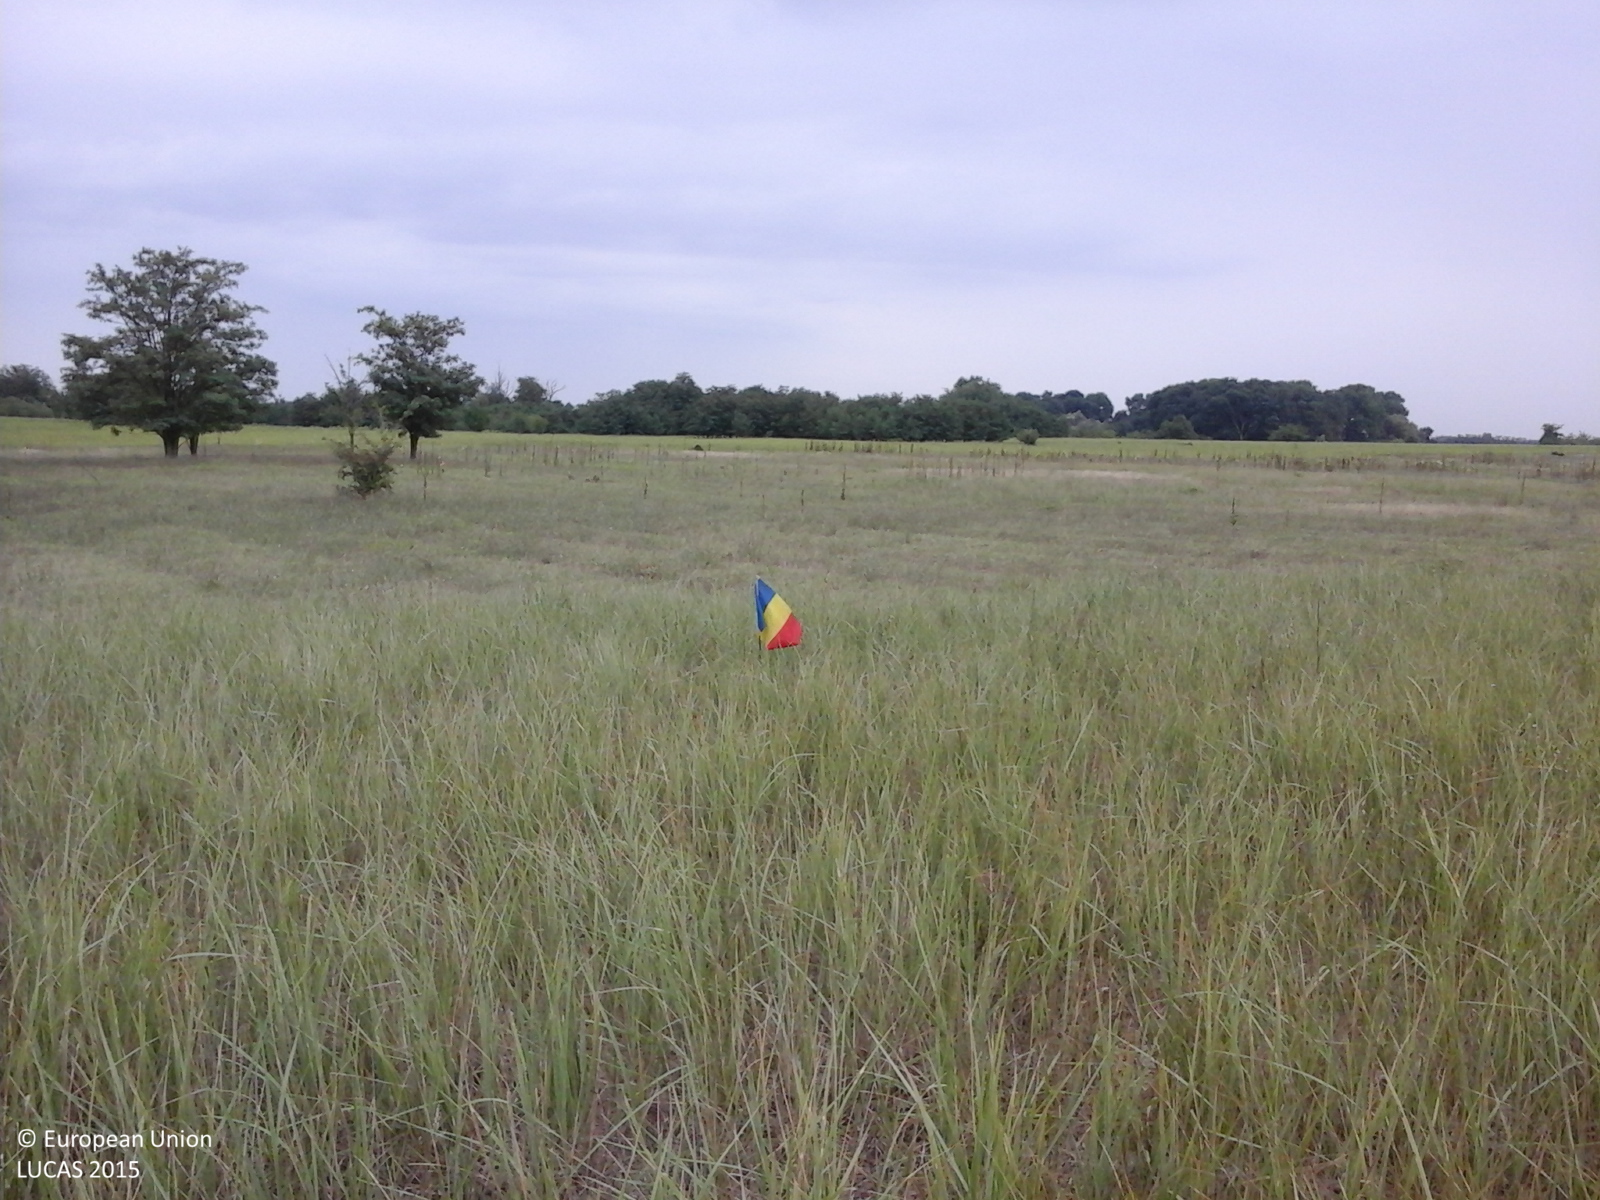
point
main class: Grassland
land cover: Spontaneously vegetated surfaces
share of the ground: > 75 %
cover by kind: herbaceous plants 100 %
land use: Fallow land
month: September
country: RO
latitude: 47.5389
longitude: 22.0738
